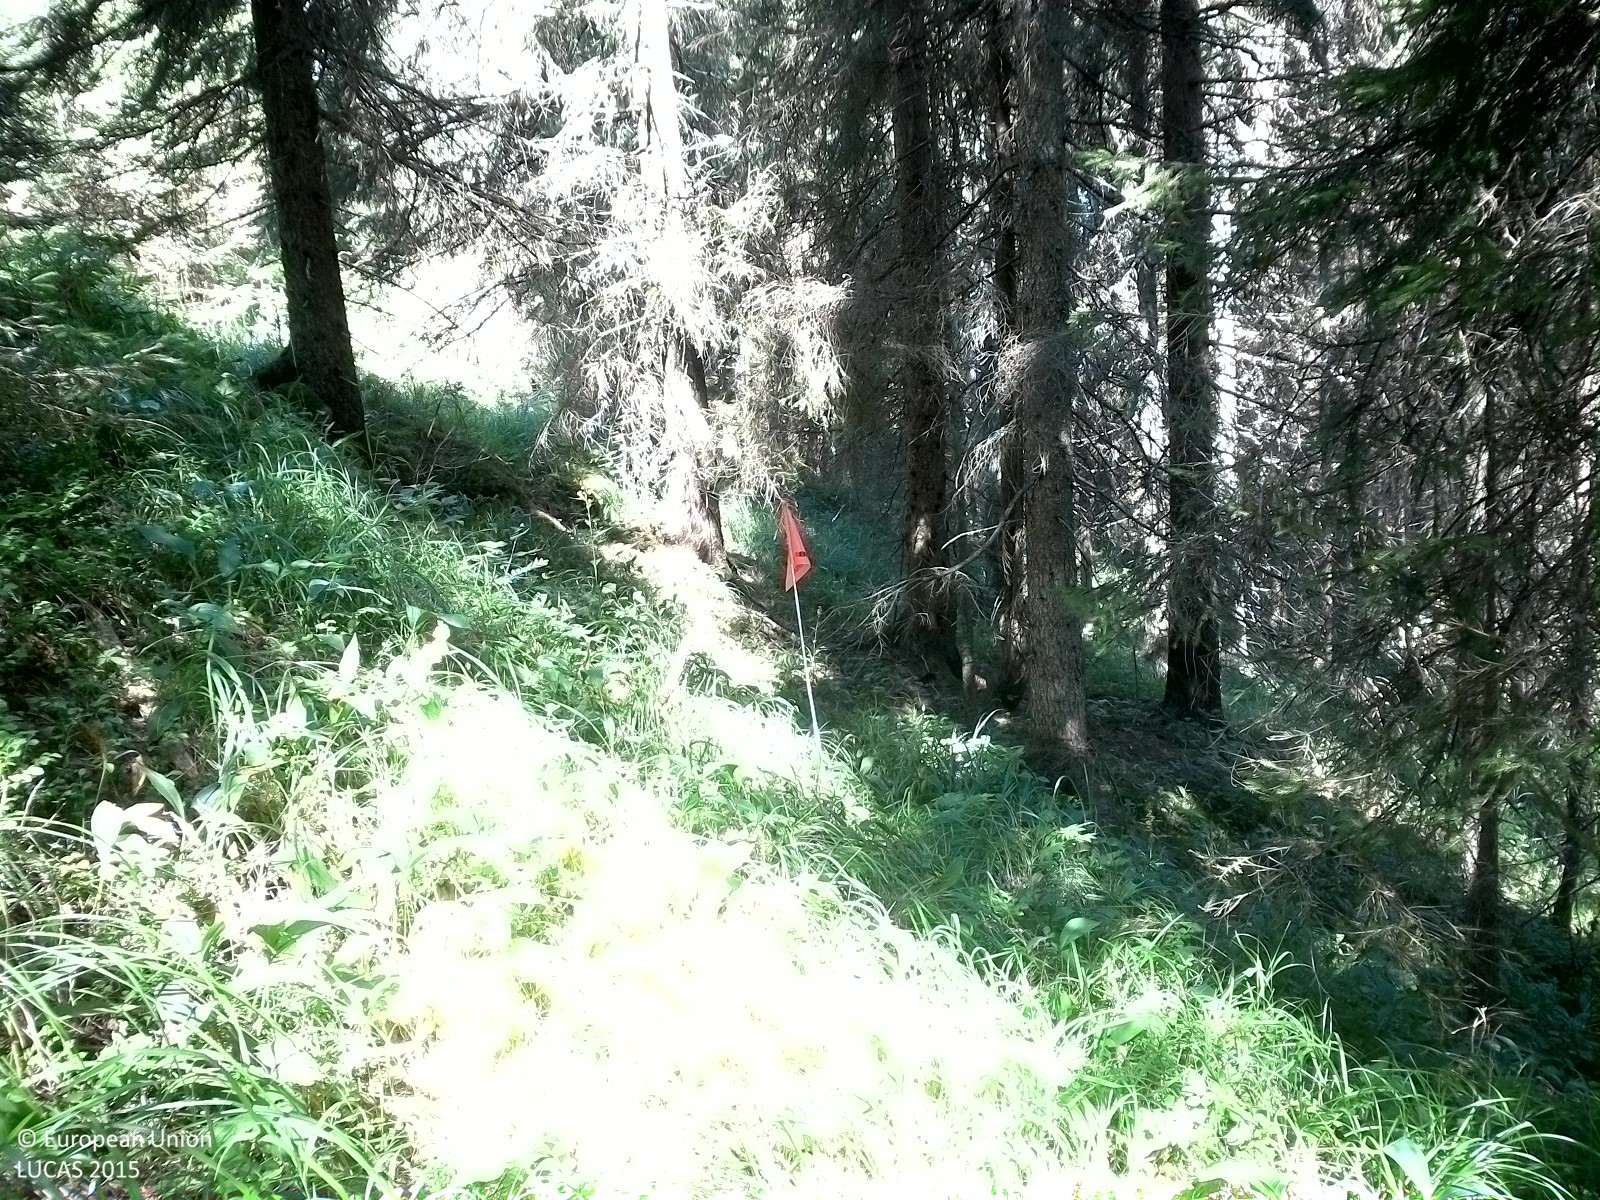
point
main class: Woodland
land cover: Spruce dominated coniferous woodland
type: boreal forest
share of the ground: 50 - 75 %
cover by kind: coniferous forest trees 60 %, herbaceous plants 20 %, lichens and mosses 20 %
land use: Forestry
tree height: > 5 m
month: August
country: SE
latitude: 59.4149
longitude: 14.7661
